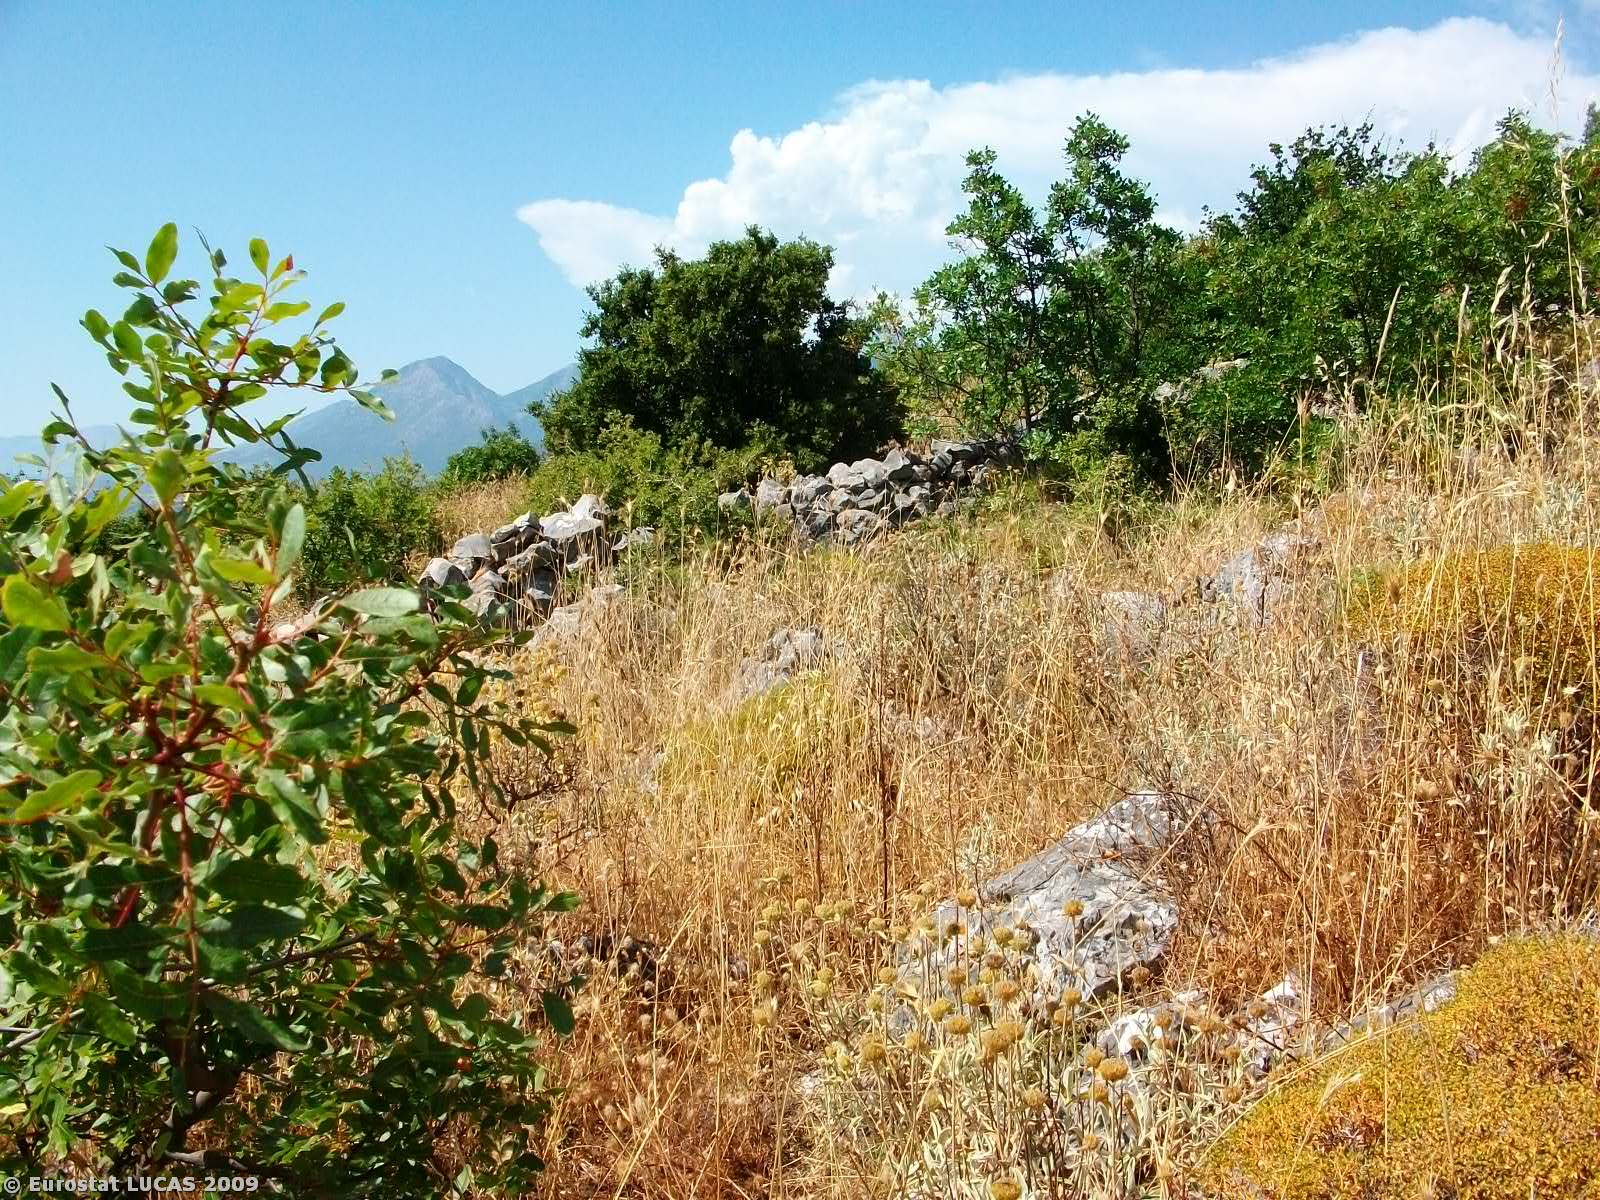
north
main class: Shrubland
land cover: Shrubland with sparse tree cover
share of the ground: > 75 %
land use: Unused
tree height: < 5 m
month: June
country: GR
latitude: 36.7974
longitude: 22.3129
